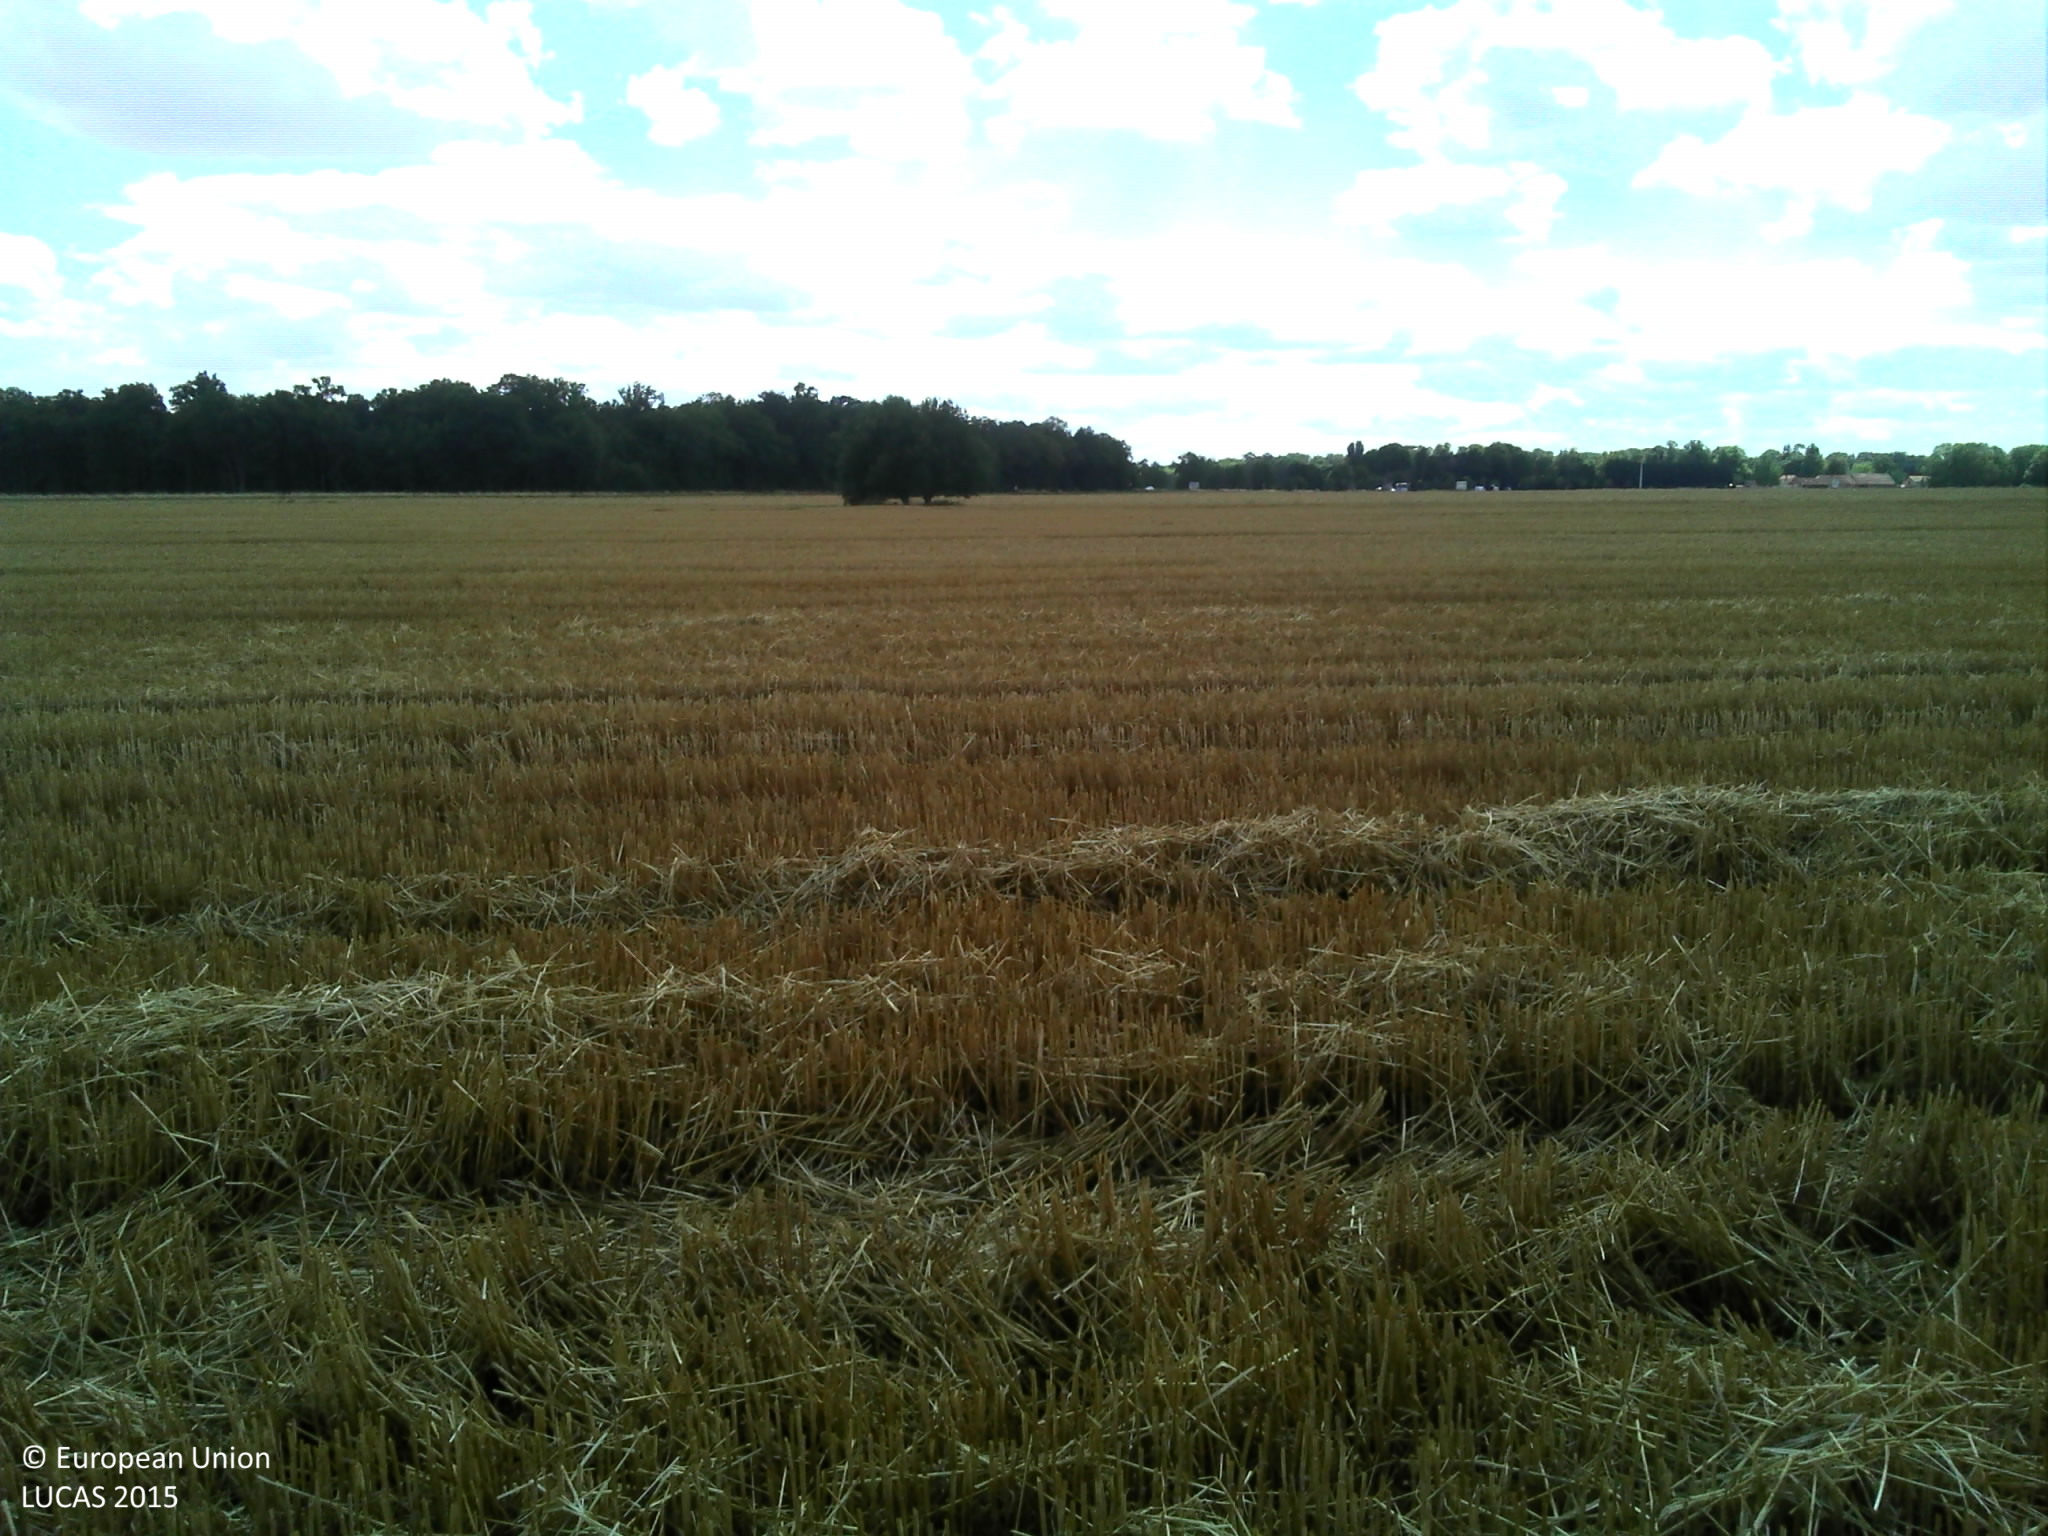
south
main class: Cropland
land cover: Common wheat
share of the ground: > 75 %
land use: Agriculture (excluding fallow land and kitchen gardens)
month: July
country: FR
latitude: 48.7210
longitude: 2.9638
